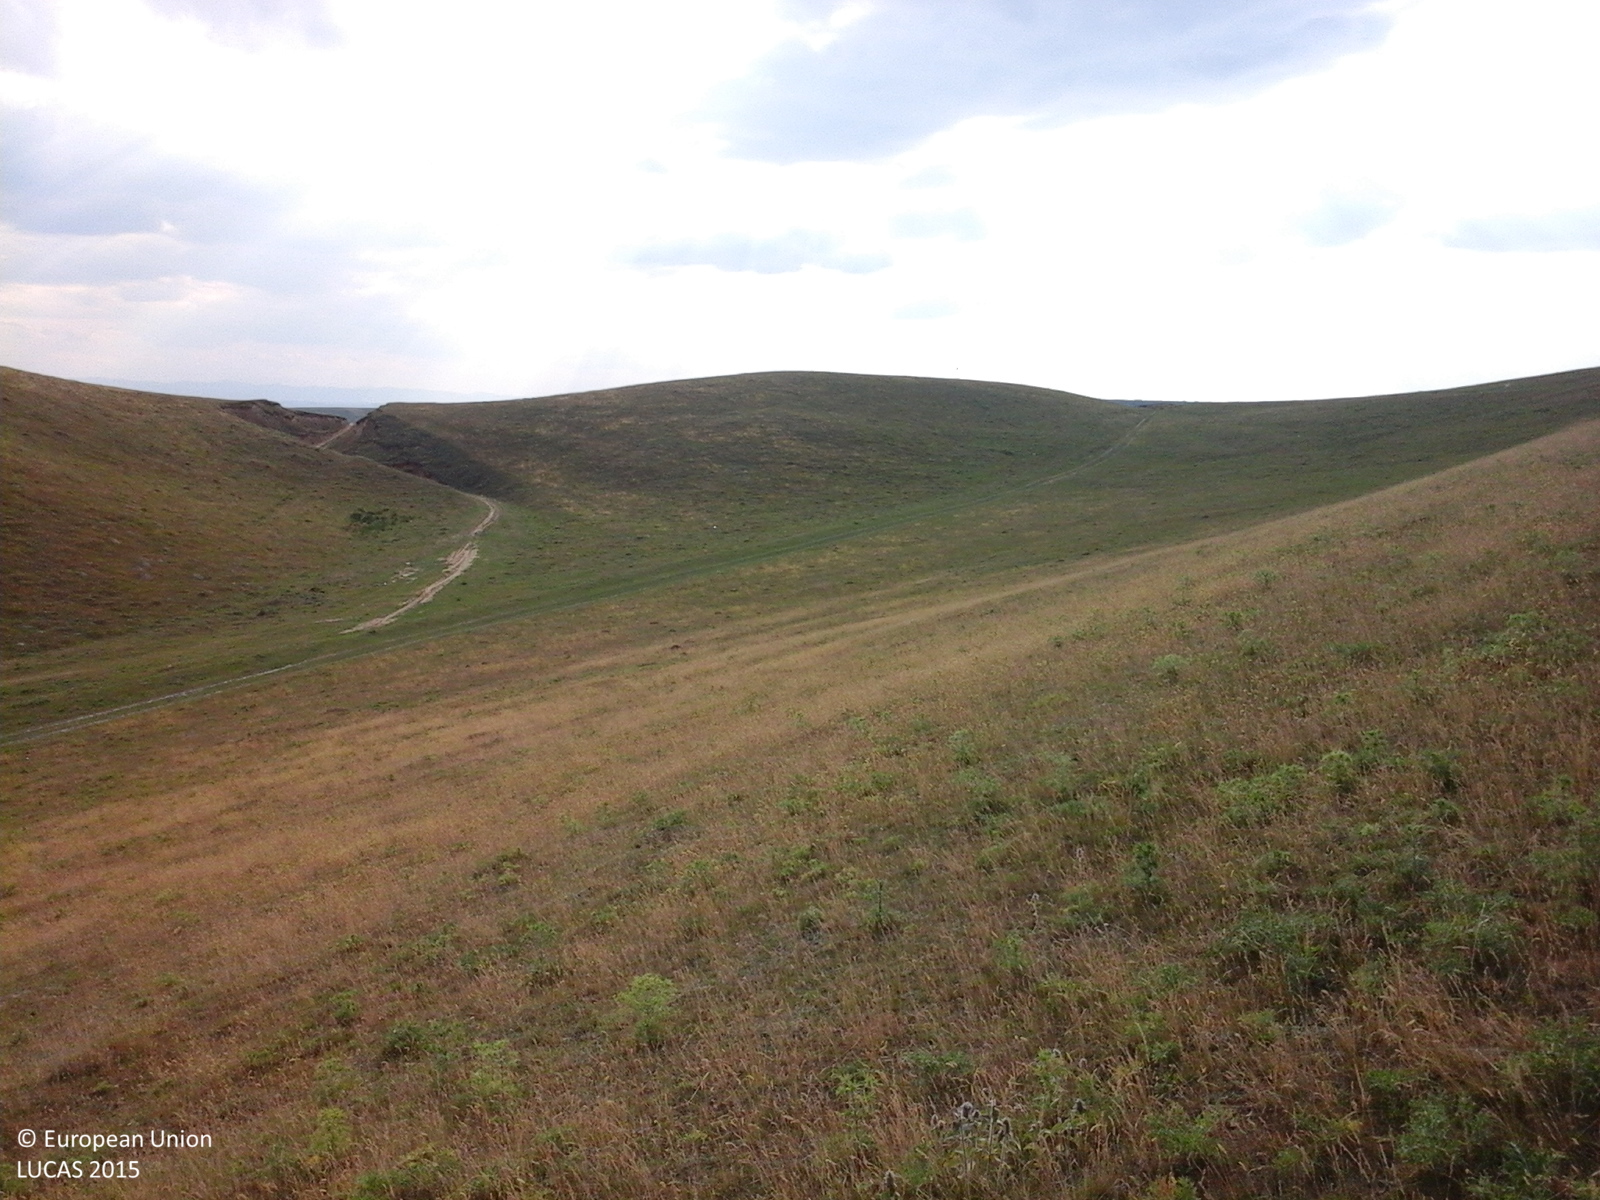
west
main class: Grassland
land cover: Grassland without tree/shrub cover
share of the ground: > 75 %
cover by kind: herbaceous plants 100 %
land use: Agriculture (excluding fallow land and kitchen gardens)
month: June
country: RO
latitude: 47.5506
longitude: 26.4179
